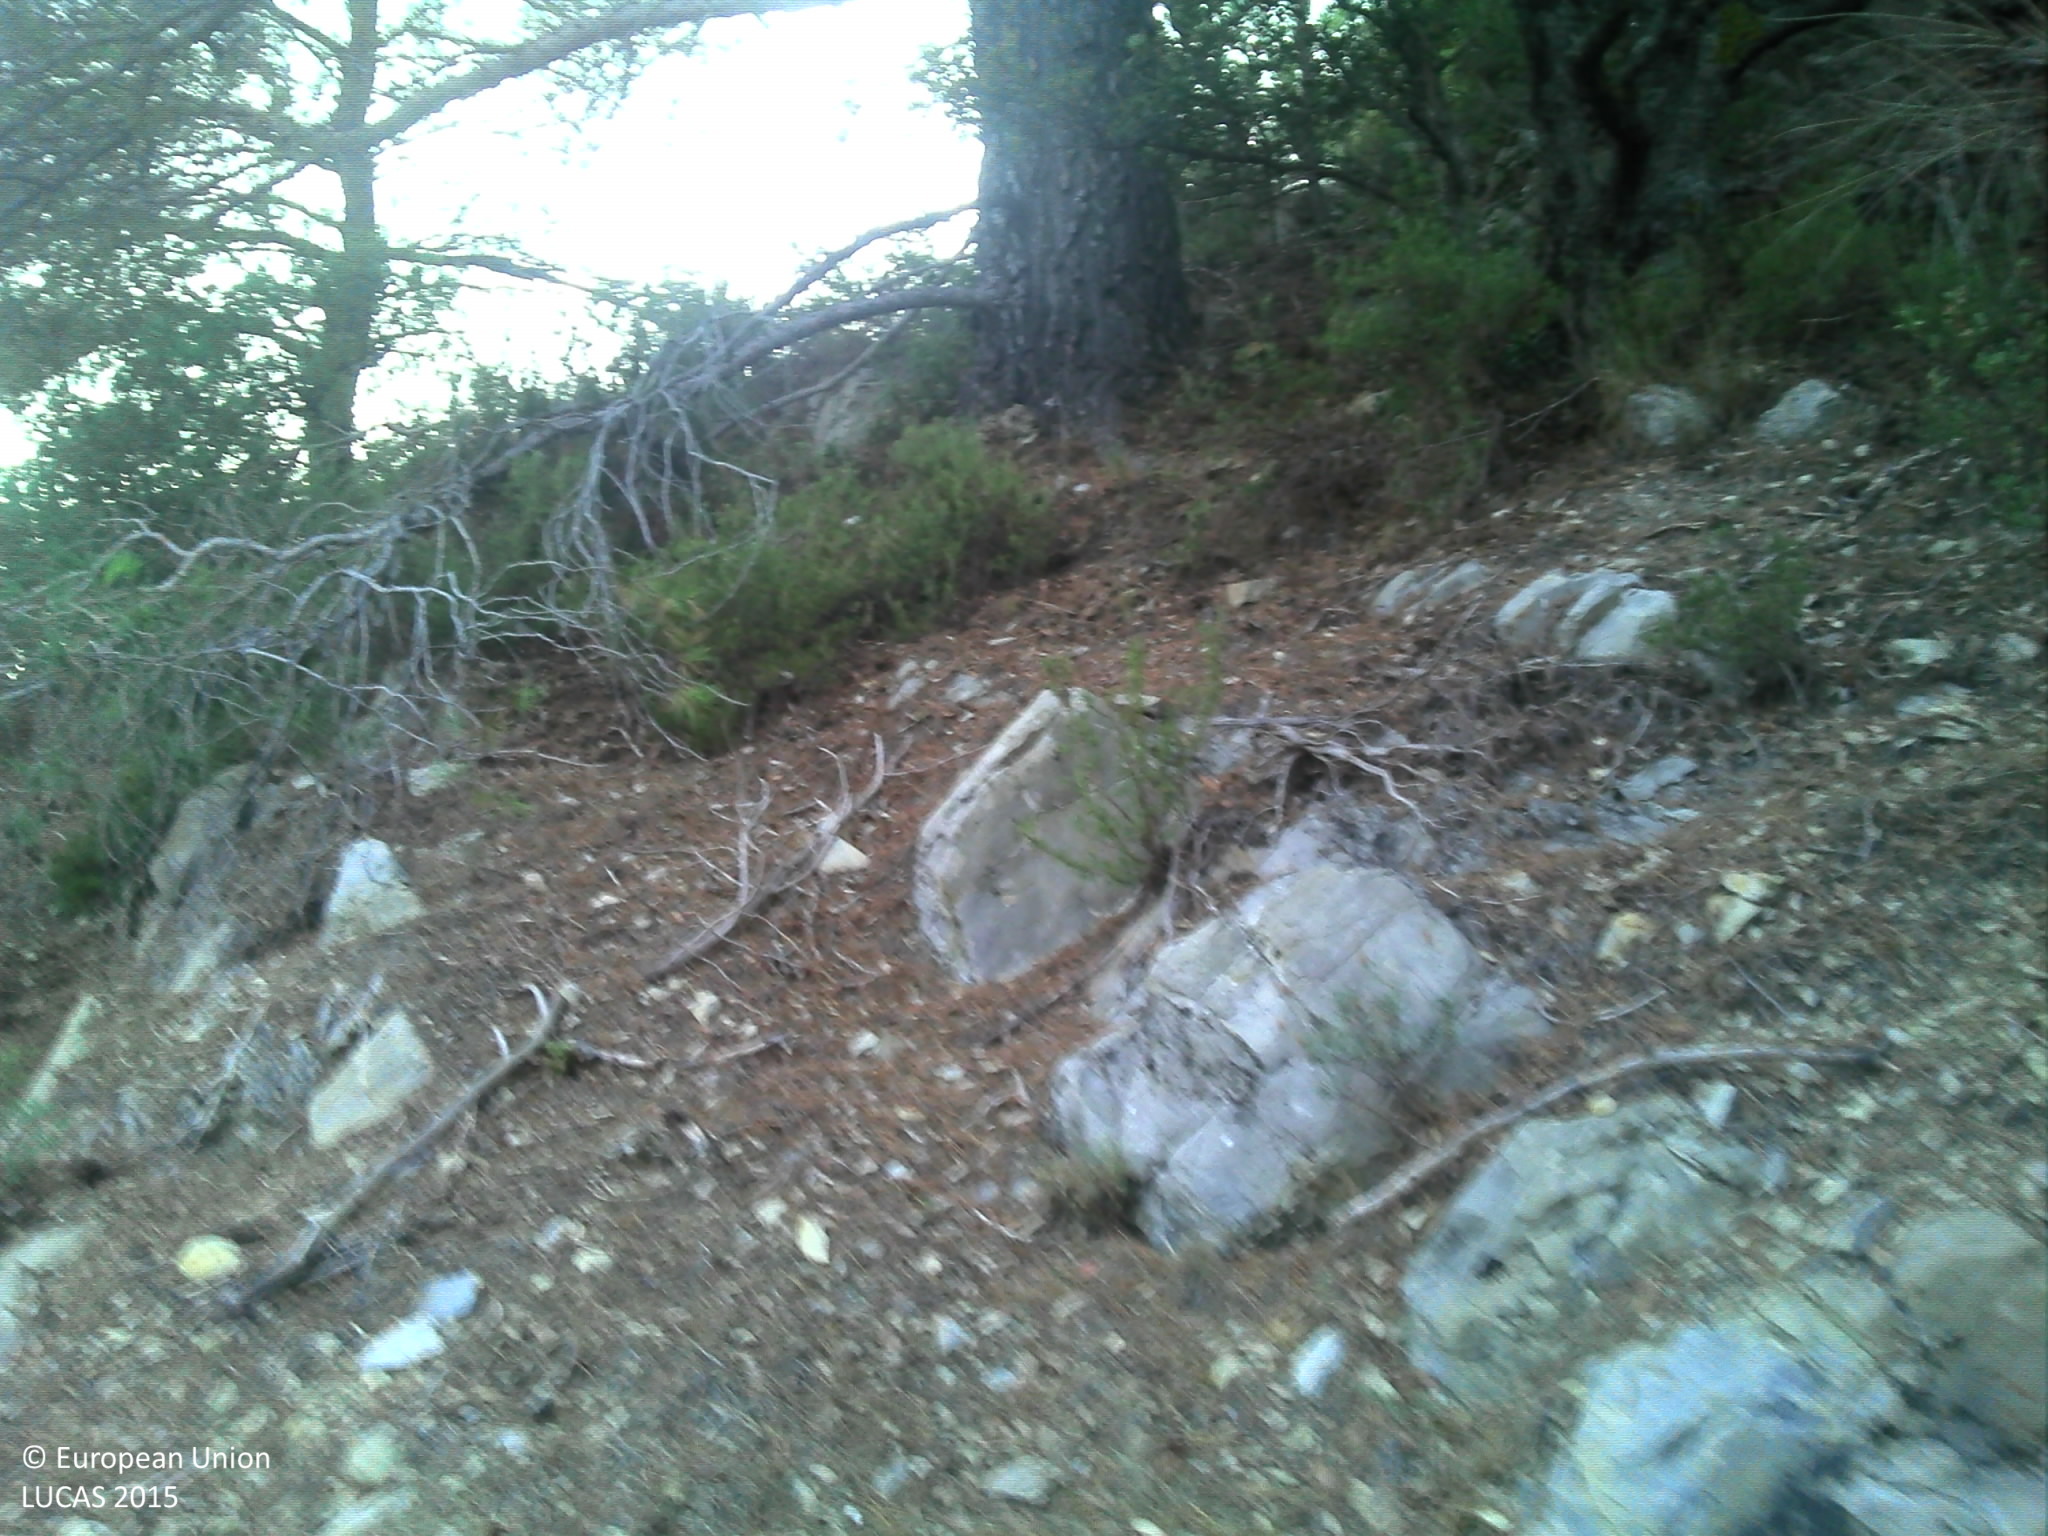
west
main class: Woodland
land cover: Pine dominated mixed woodland
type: thermophilous deciduous forest
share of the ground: > 75 %
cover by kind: coniferous forest trees 30 %, broadleaved forest trees 30 %, unconsolidated bare surface 20 %, shrubs 10 %, herbaceous plants 10 %
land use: Semi-natural and natural areas not in use
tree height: > 5 m
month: August
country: FR
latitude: 43.5523
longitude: 5.5905
